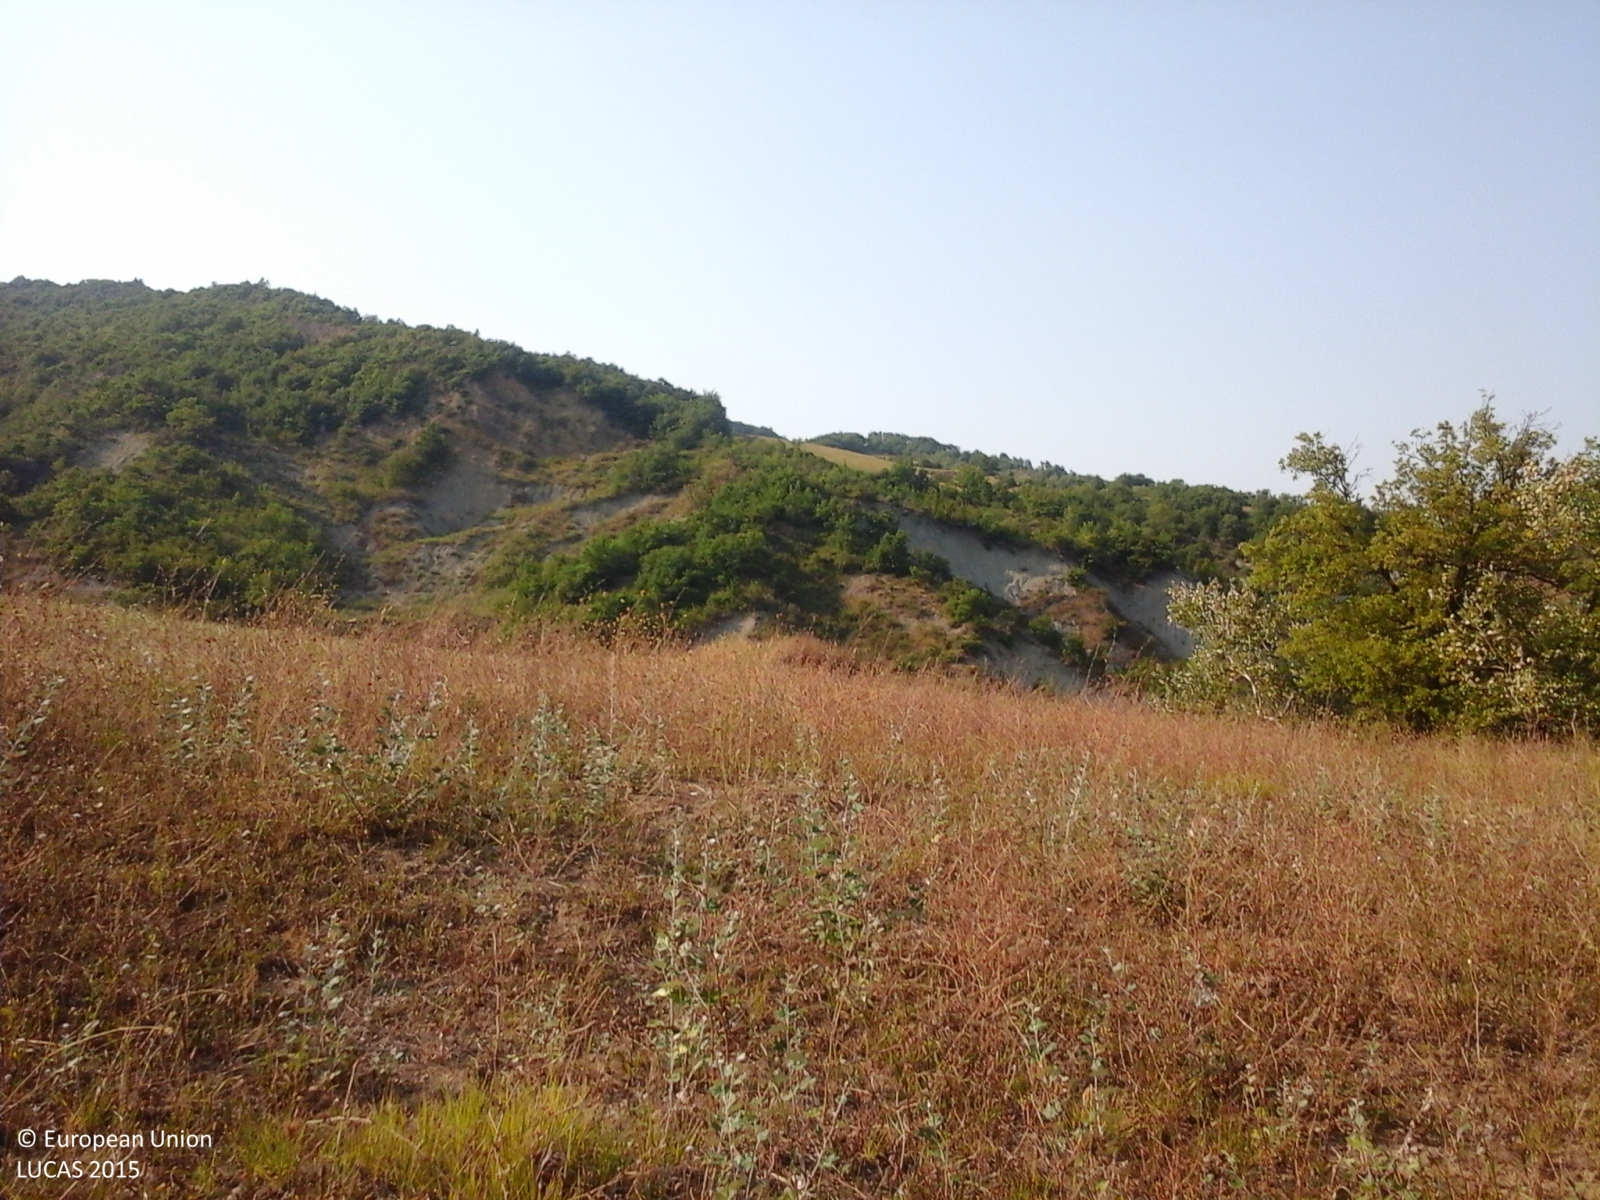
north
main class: Shrubland
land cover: Shrubland with sparse tree cover
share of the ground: > 75 %
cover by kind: shrubs 95 %, broadleaved forest trees 5 %
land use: Semi-natural and natural areas not in use
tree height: < 5 m
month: August
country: IT
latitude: 43.7443
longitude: 12.4402
